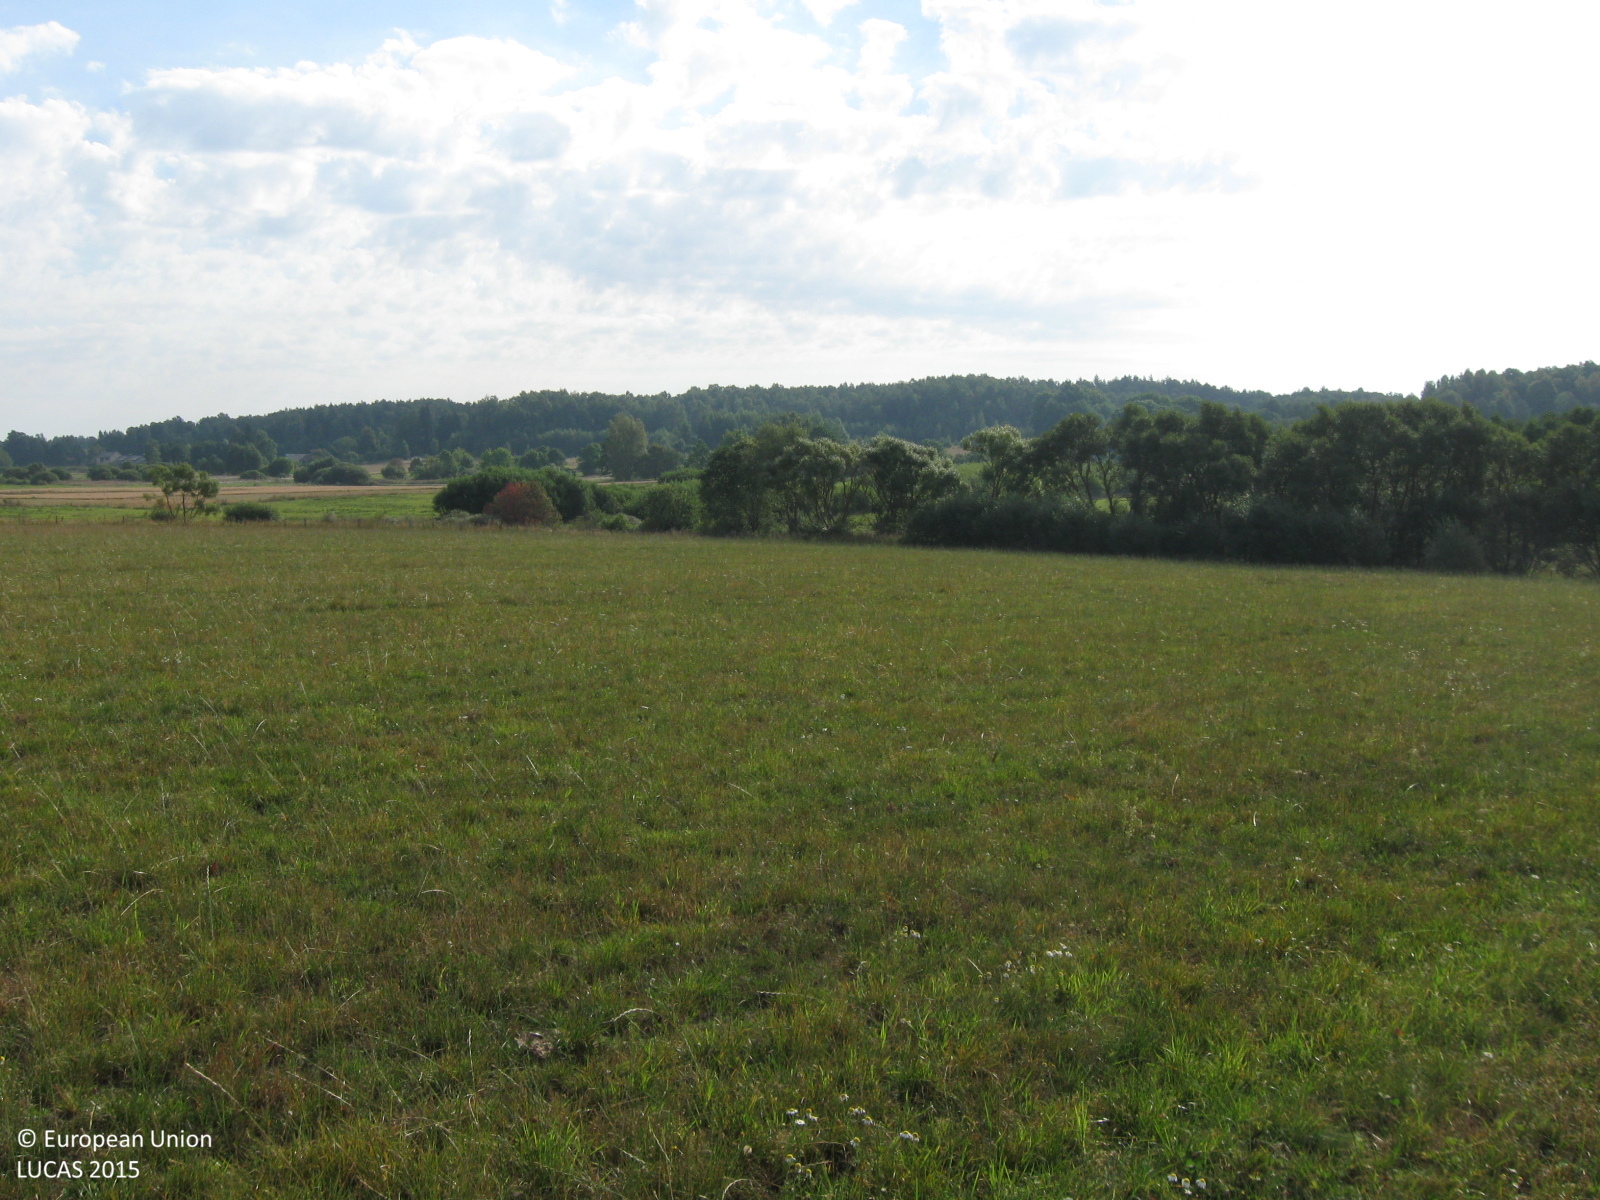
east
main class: Grassland
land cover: Grassland without tree/shrub cover
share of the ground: > 75 %
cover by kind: herbaceous plants 100 %
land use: Agriculture (excluding fallow land and kitchen gardens)
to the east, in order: Grassland without tree/shrub cover; Fences; Spontaneously vegetated surfaces; Broadleaved woodland; Rivers and streams; Broadleaved woodland; Spontaneously vegetated surfaces; Fences; Grassland without tree/shrub cover; Fences; Shruby margins; Abandoned hedges; Grassland without tree/shrub cover
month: August
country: LT
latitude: 55.4400
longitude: 22.9192
